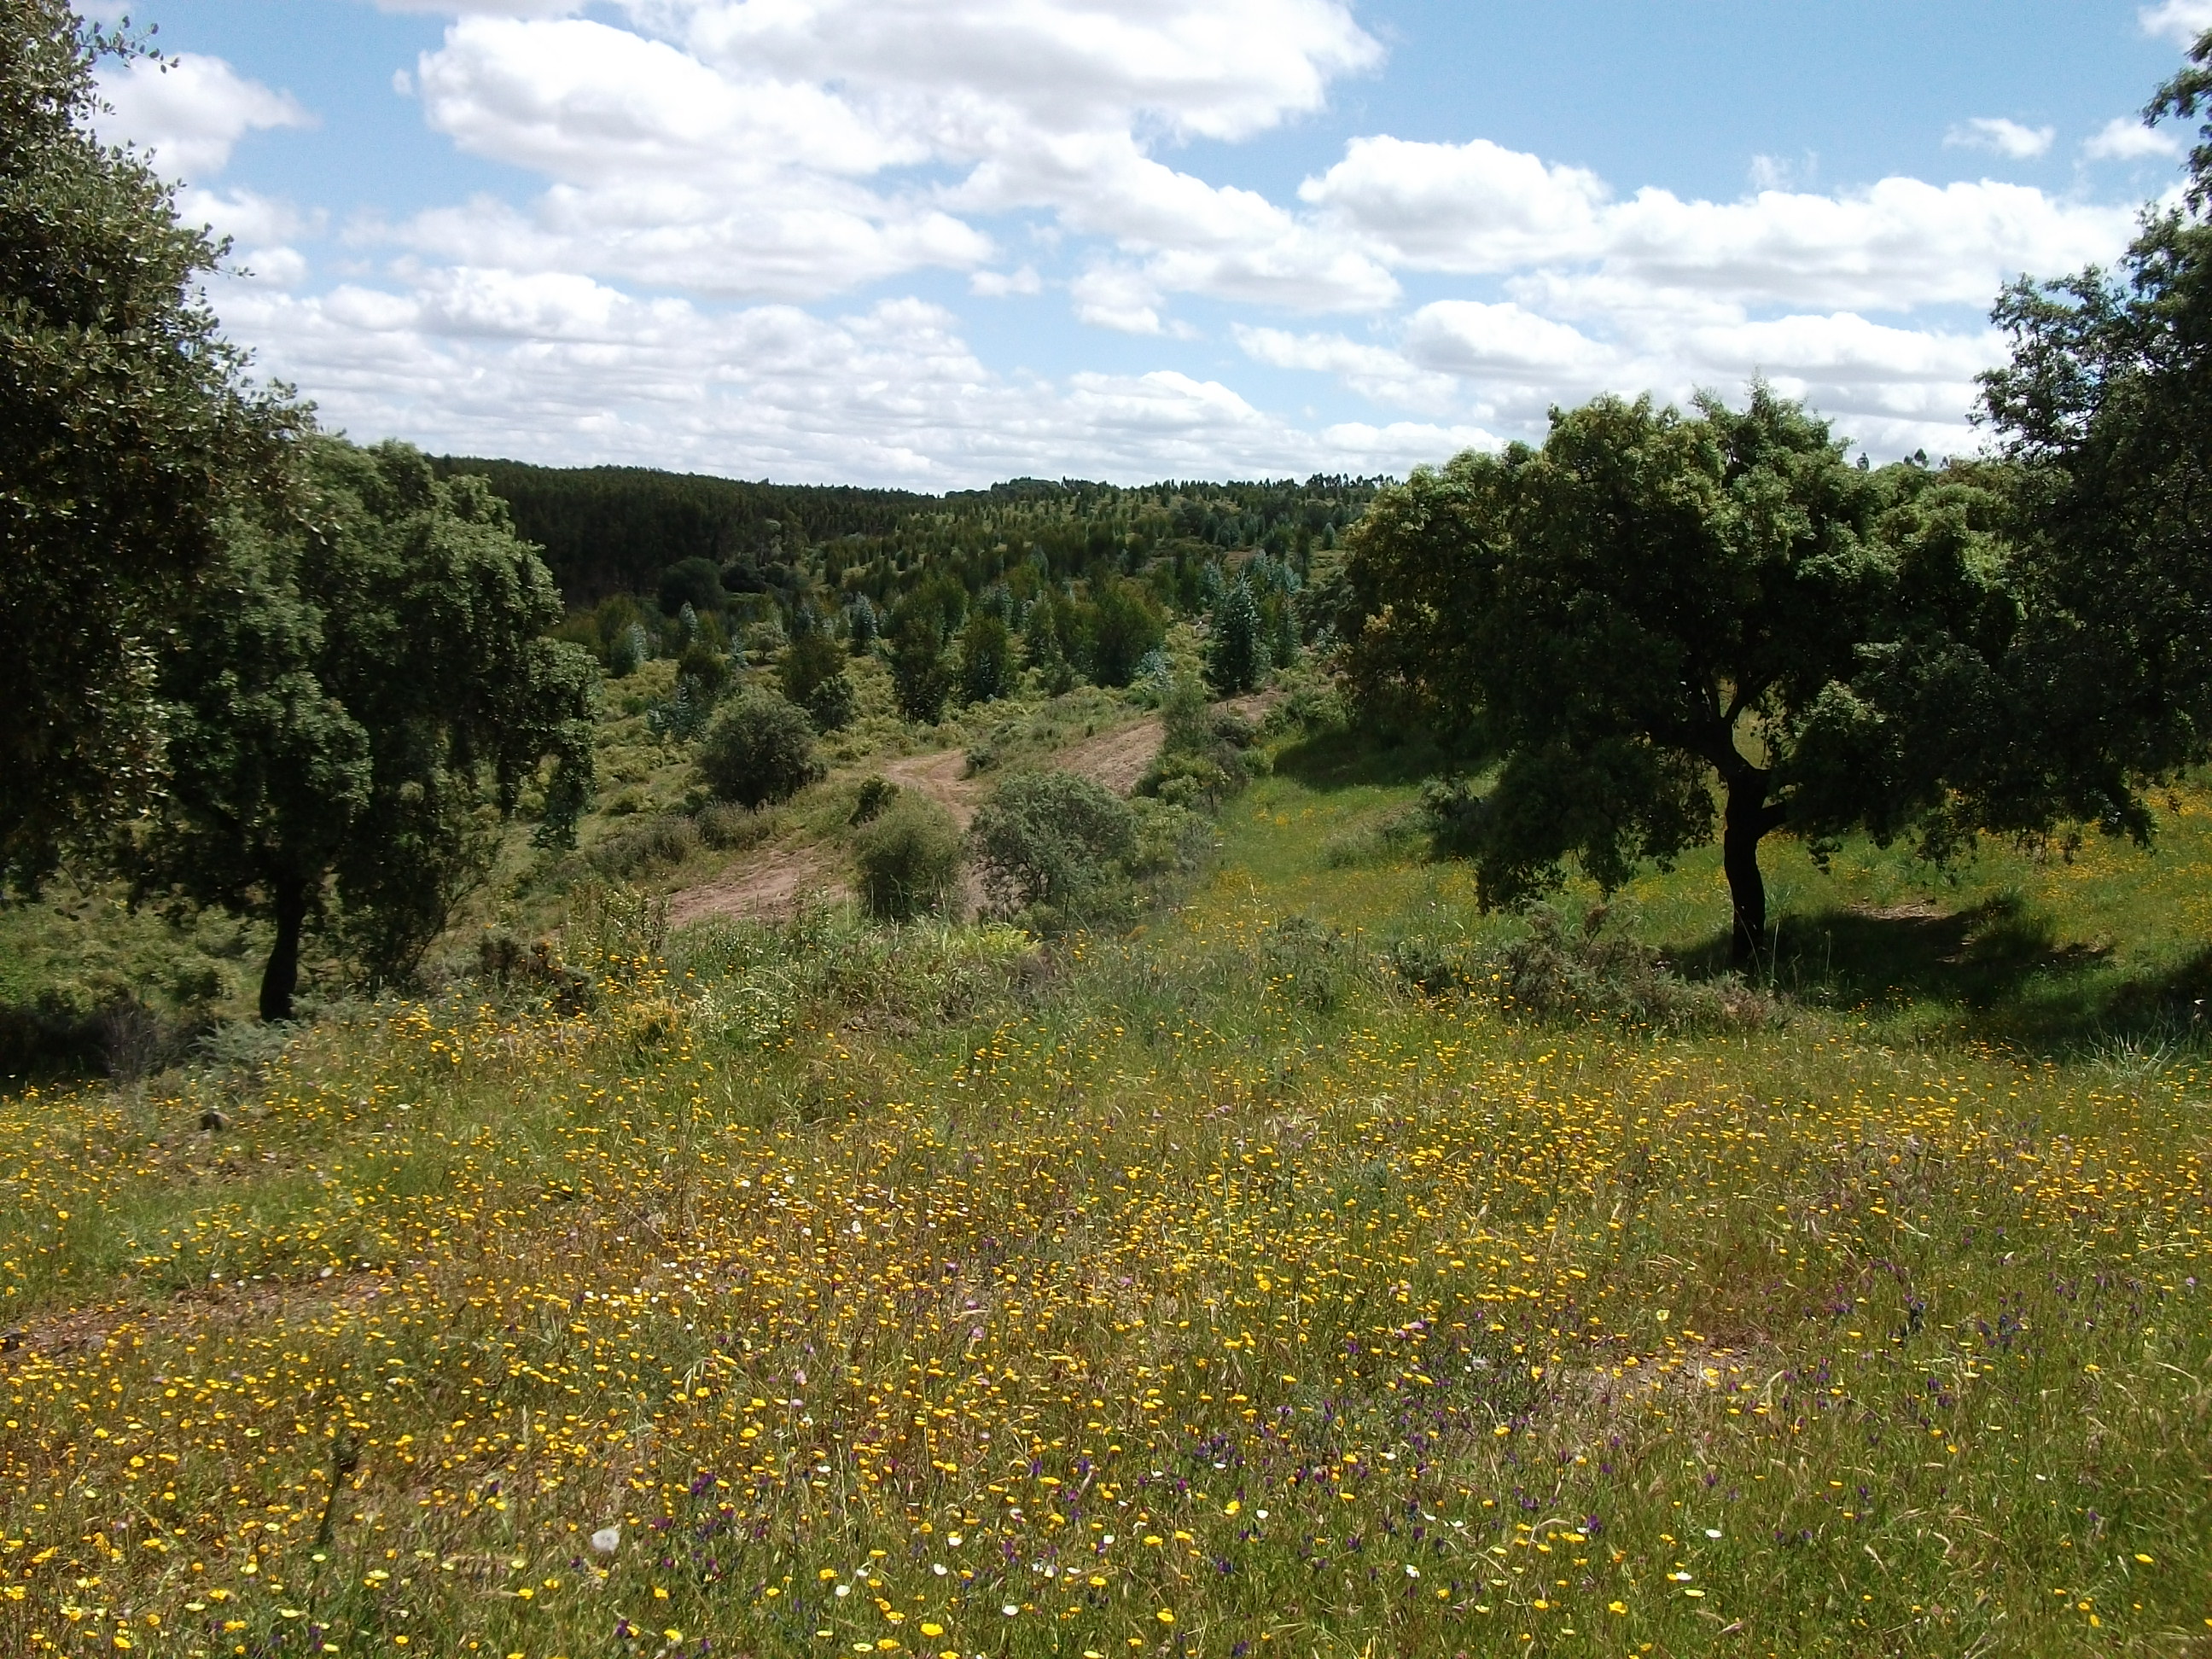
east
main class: Woodland
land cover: Broadleaved woodland
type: broadleaved evergreen forest
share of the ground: 10 - 25 %
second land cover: Grassland without tree/shrub cover
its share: > 75 %
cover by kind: herbaceous plants 85 %, broadleaved forest trees 10 %, shrubs 5 %
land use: Forestry
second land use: Agriculture (excluding fallow land and kitchen gardens)
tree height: > 5 m
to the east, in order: Broadleaved woodland; Grassland without tree/shrub cover; Shruby margins; Fences; Tracks; Shrubland with sparse tree cover; Tracks; Broadleaved woodland
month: May
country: ES
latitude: 37.6813
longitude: -6.6989
